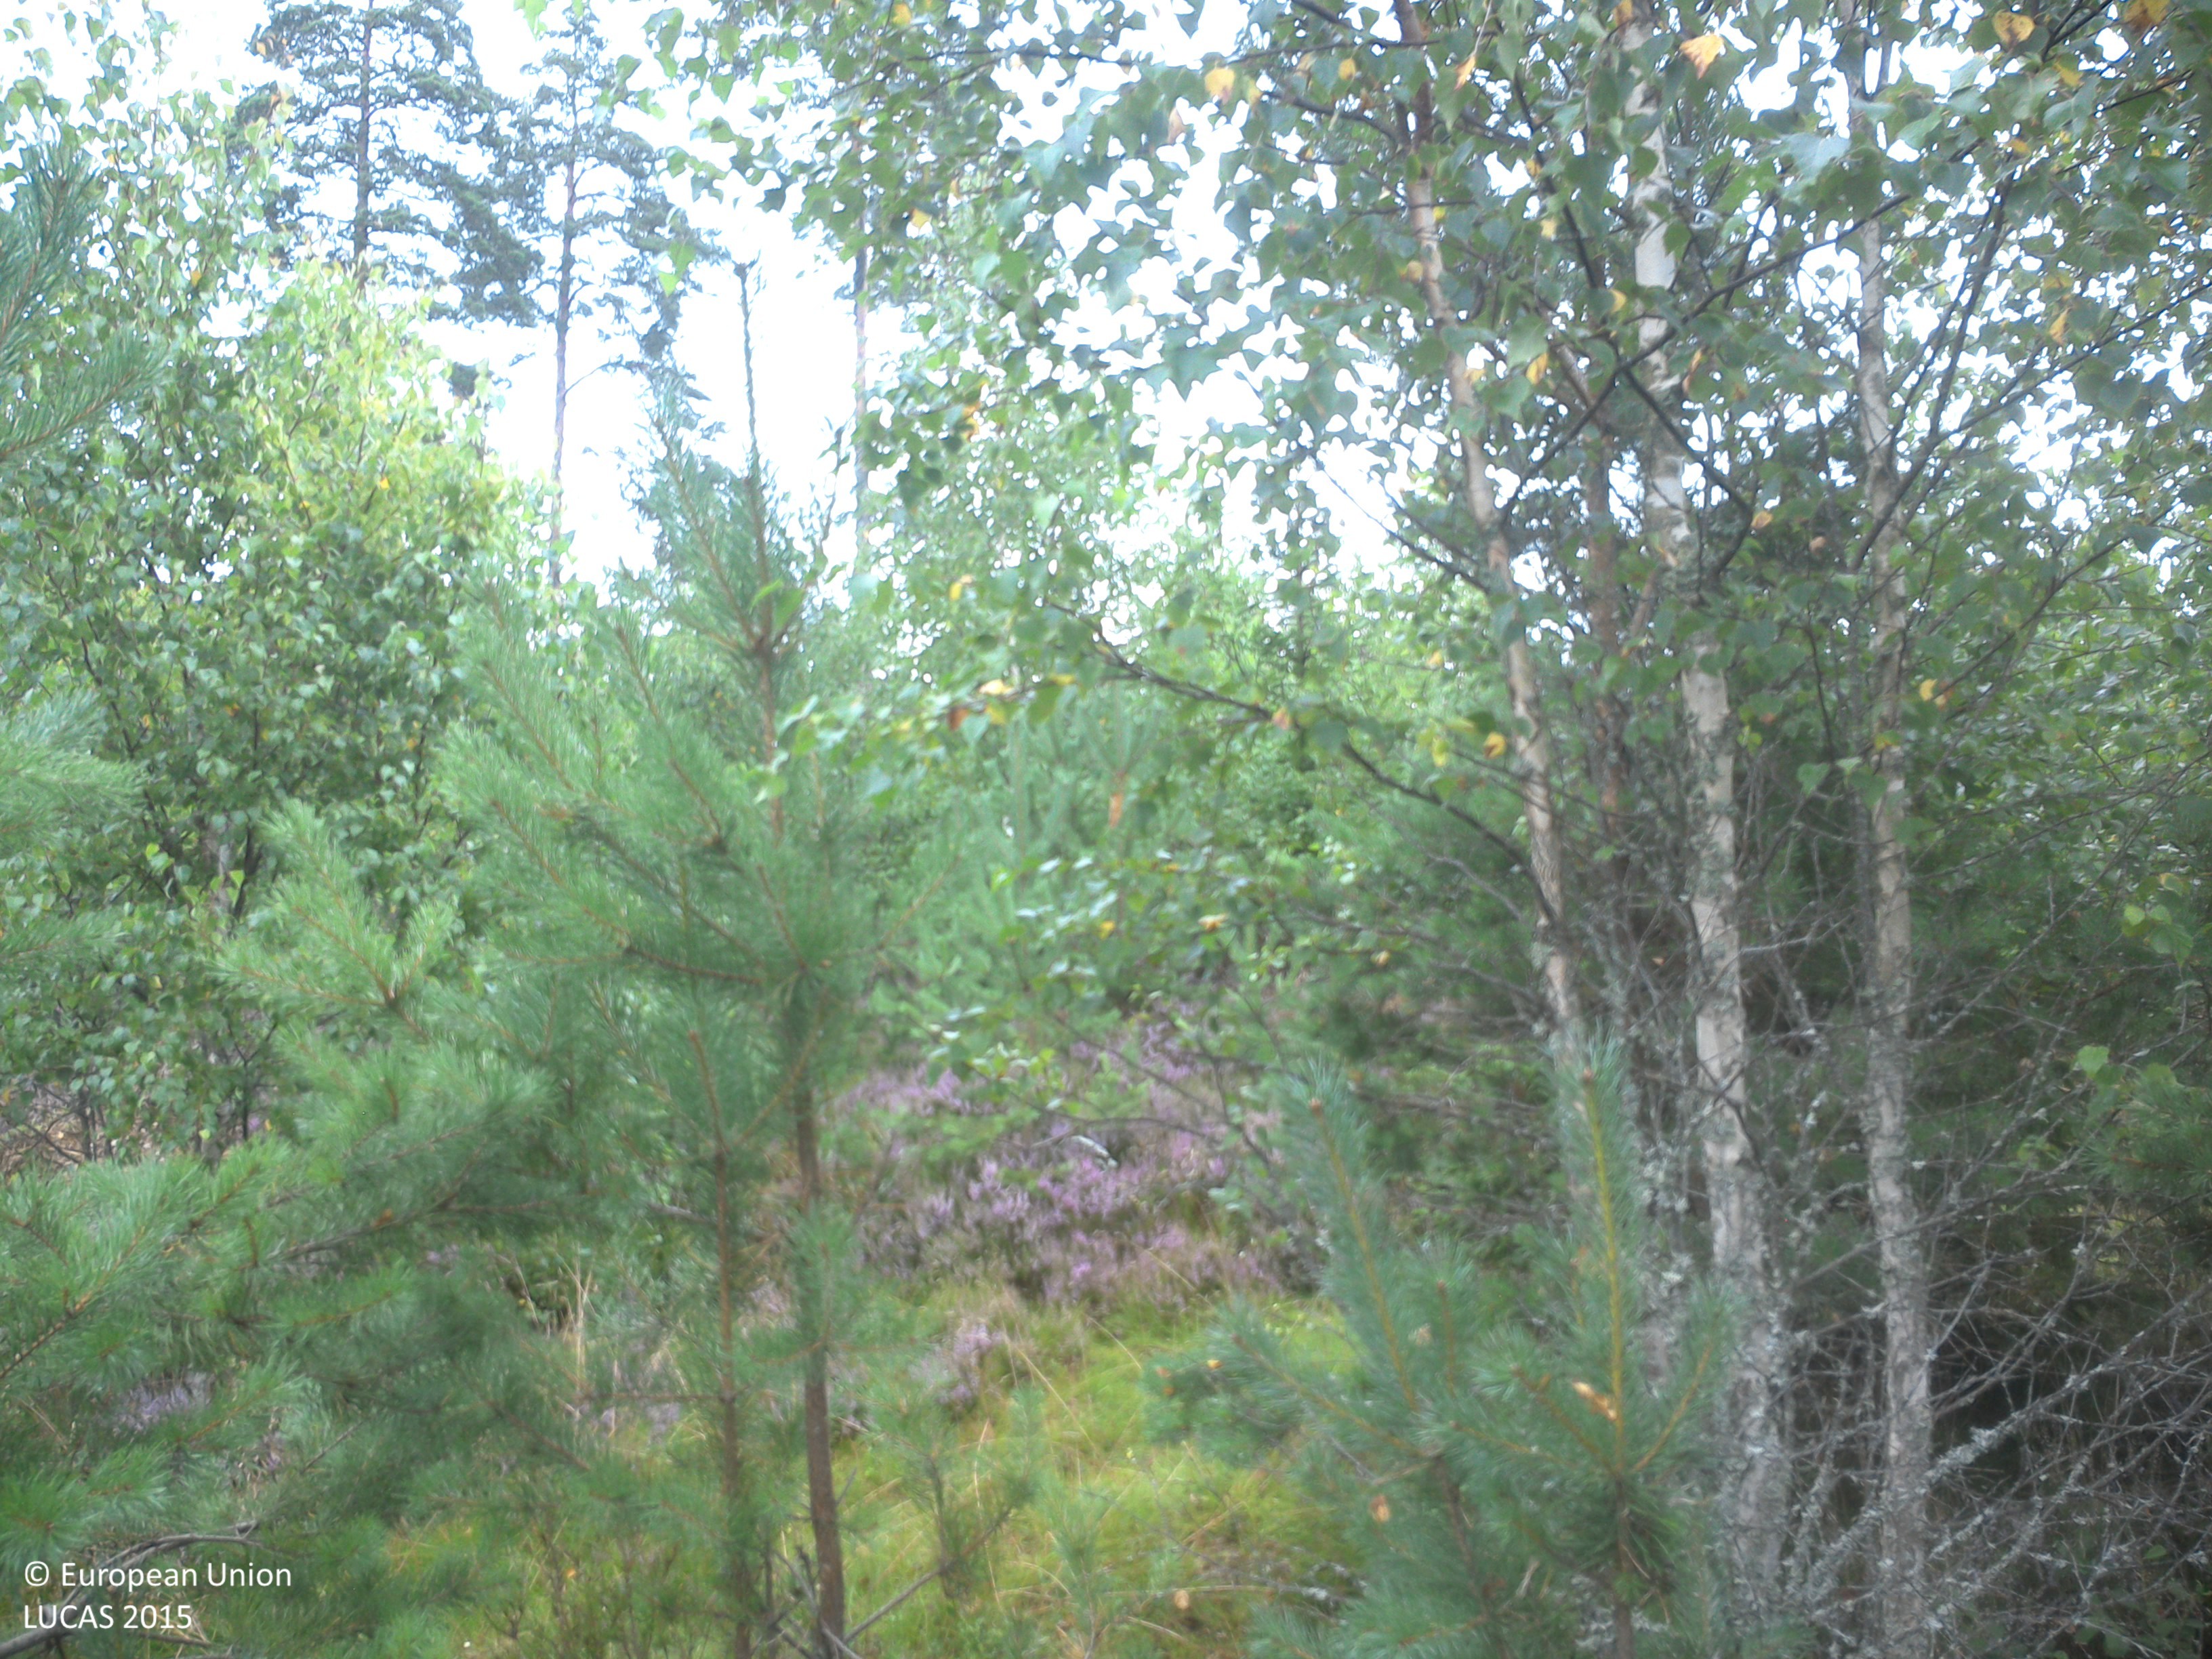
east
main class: Woodland
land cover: Pine dominated mixed woodland
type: boreal forest
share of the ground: 25 - 50 %
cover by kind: herbaceous plants 40 %, coniferous forest trees 25 %, shrubs 20 %, broadleaved forest trees 10 %, lichens and mosses 5 %
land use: Forestry
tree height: < 5 m
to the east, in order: Pine dominated mixed woodland; Paved roads, cycling and walking lanes; Pine dominated mixed woodland; Pine dominated coniferous woodland; Inland fresh water bodies
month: August
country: SE
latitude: 57.7992
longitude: 15.5316
